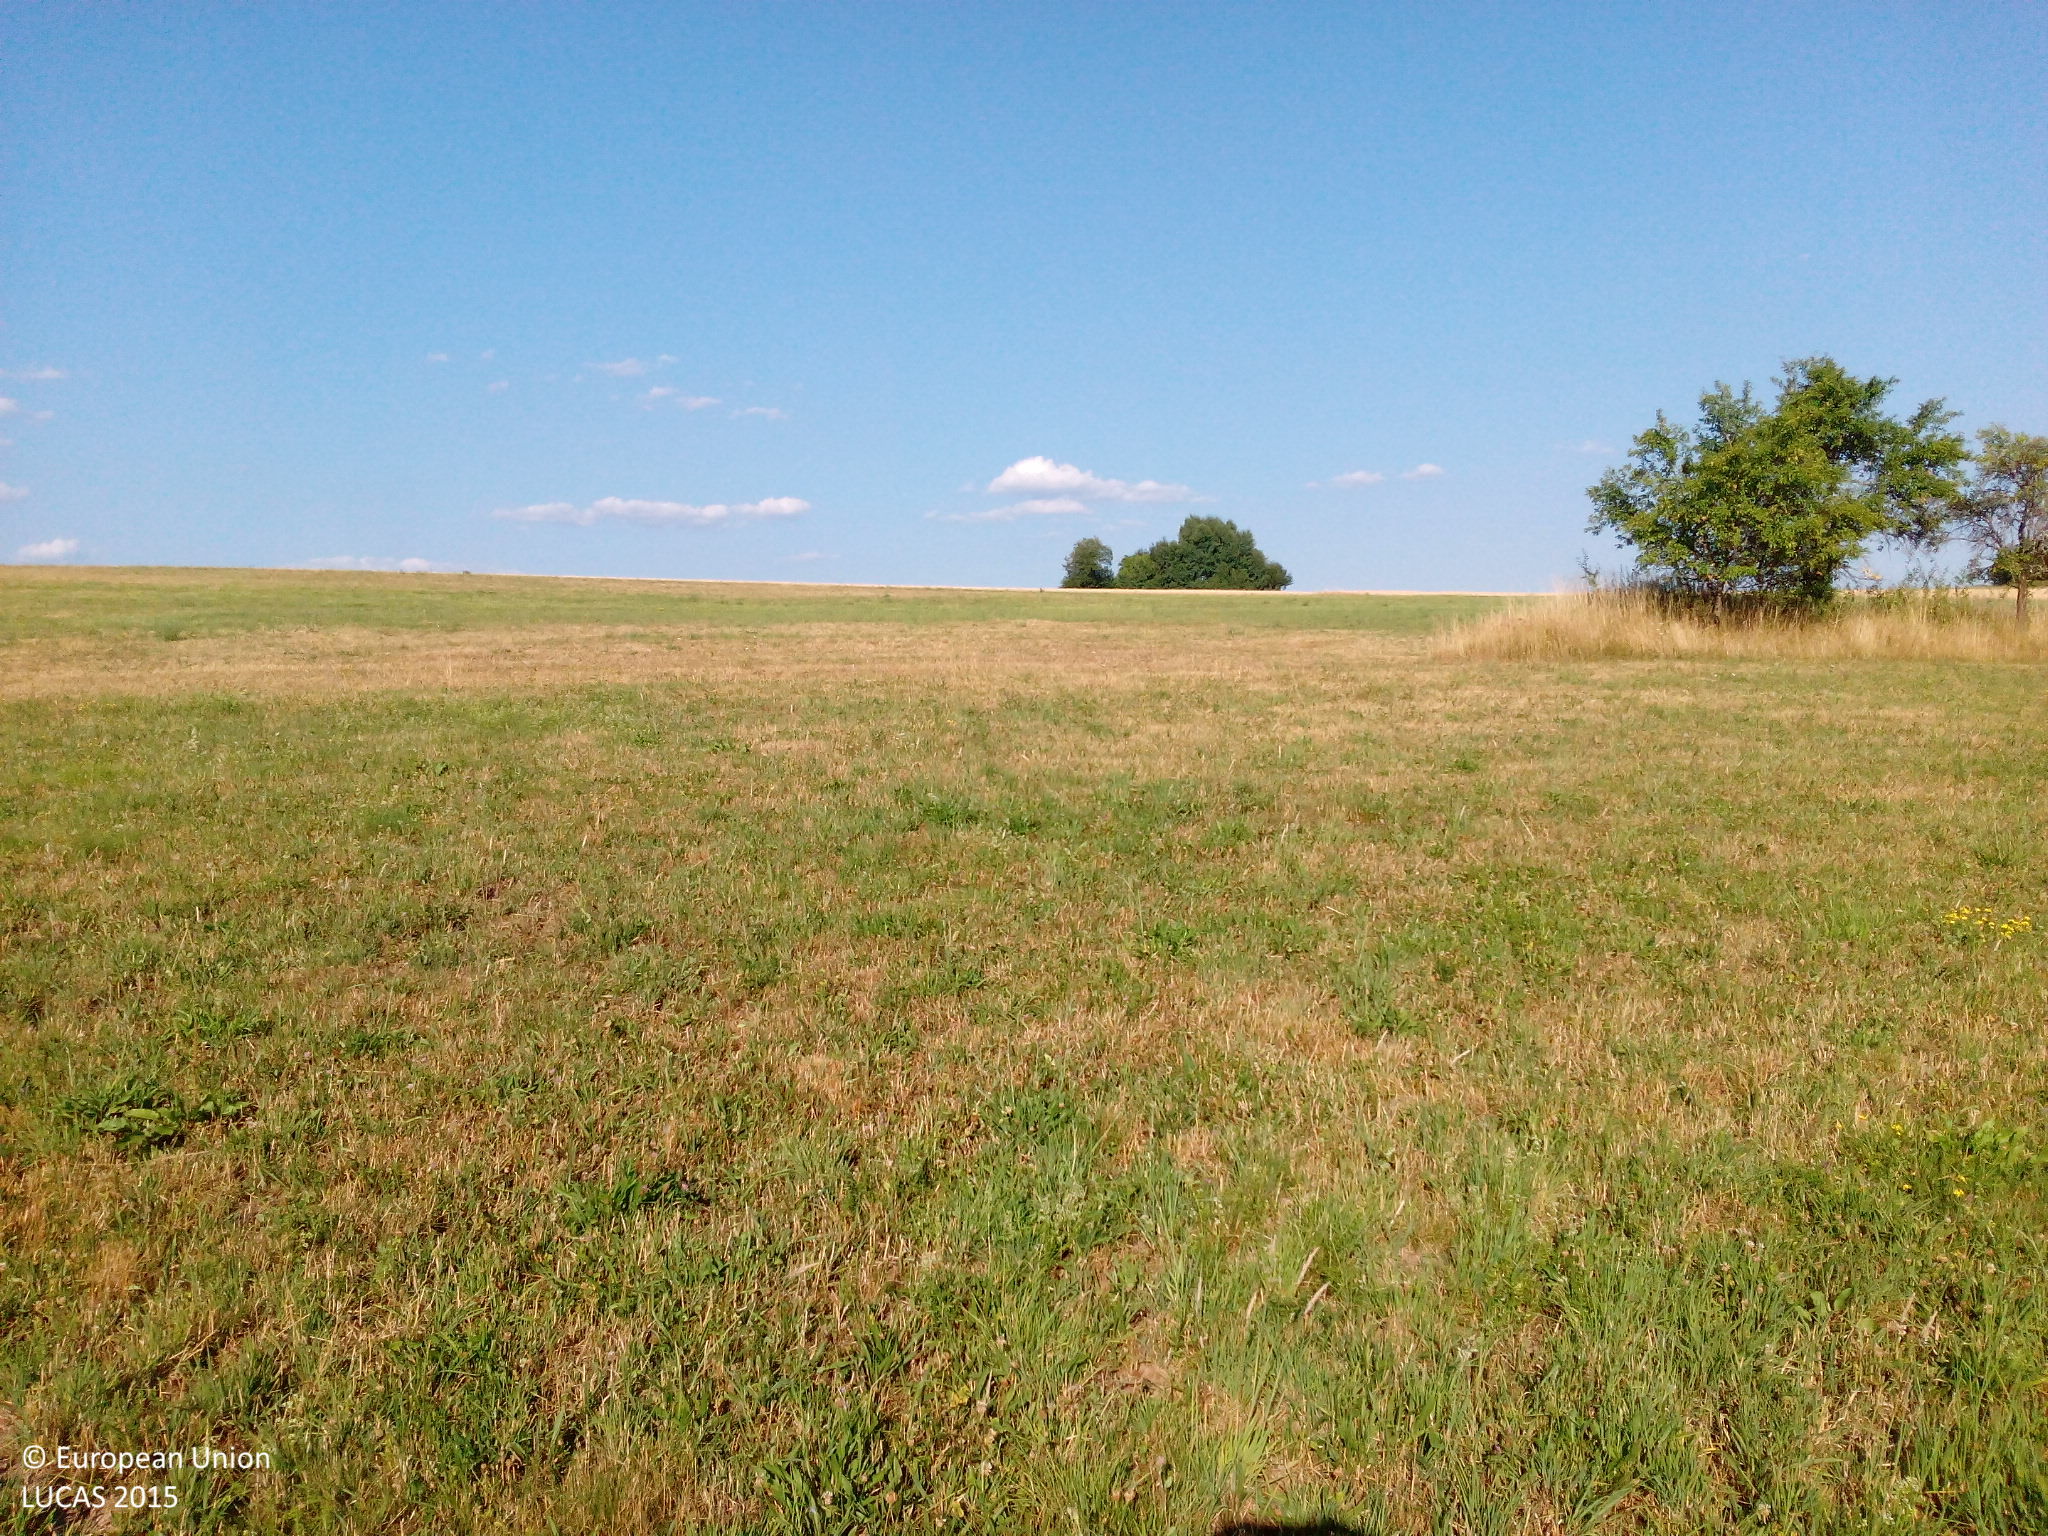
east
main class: Grassland
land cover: Grassland without tree/shrub cover
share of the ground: > 75 %
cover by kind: herbaceous plants 90 %, unconsolidated bare surface 10 %
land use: Agriculture (excluding fallow land and kitchen gardens)
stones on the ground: < 10 %
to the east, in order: Grassland without tree/shrub cover; Barley; Grassland without tree/shrub cover
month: July
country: DE
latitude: 49.1682
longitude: 7.5455
